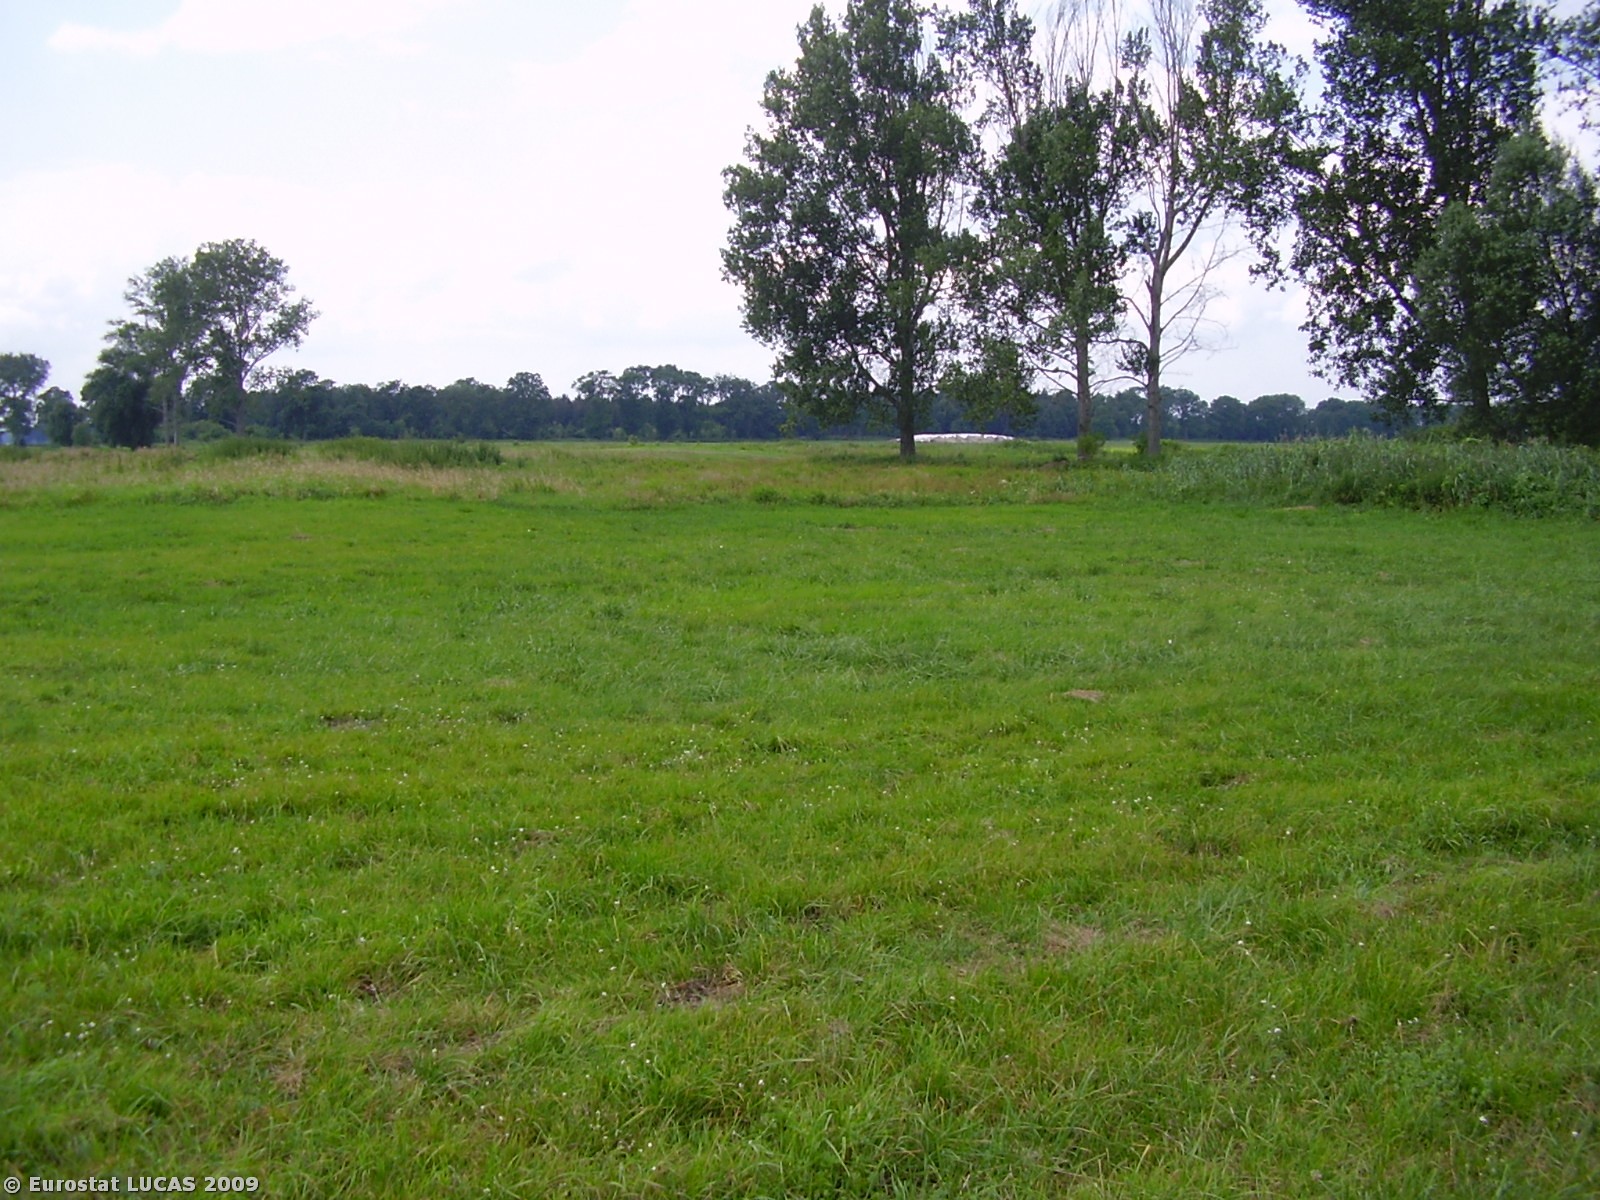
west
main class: Grassland
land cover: Grassland without tree/shrub cover
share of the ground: > 75 %
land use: Agriculture (excluding fallow land and kitchen gardens)
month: July
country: PL
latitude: 52.0499
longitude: 16.2624
